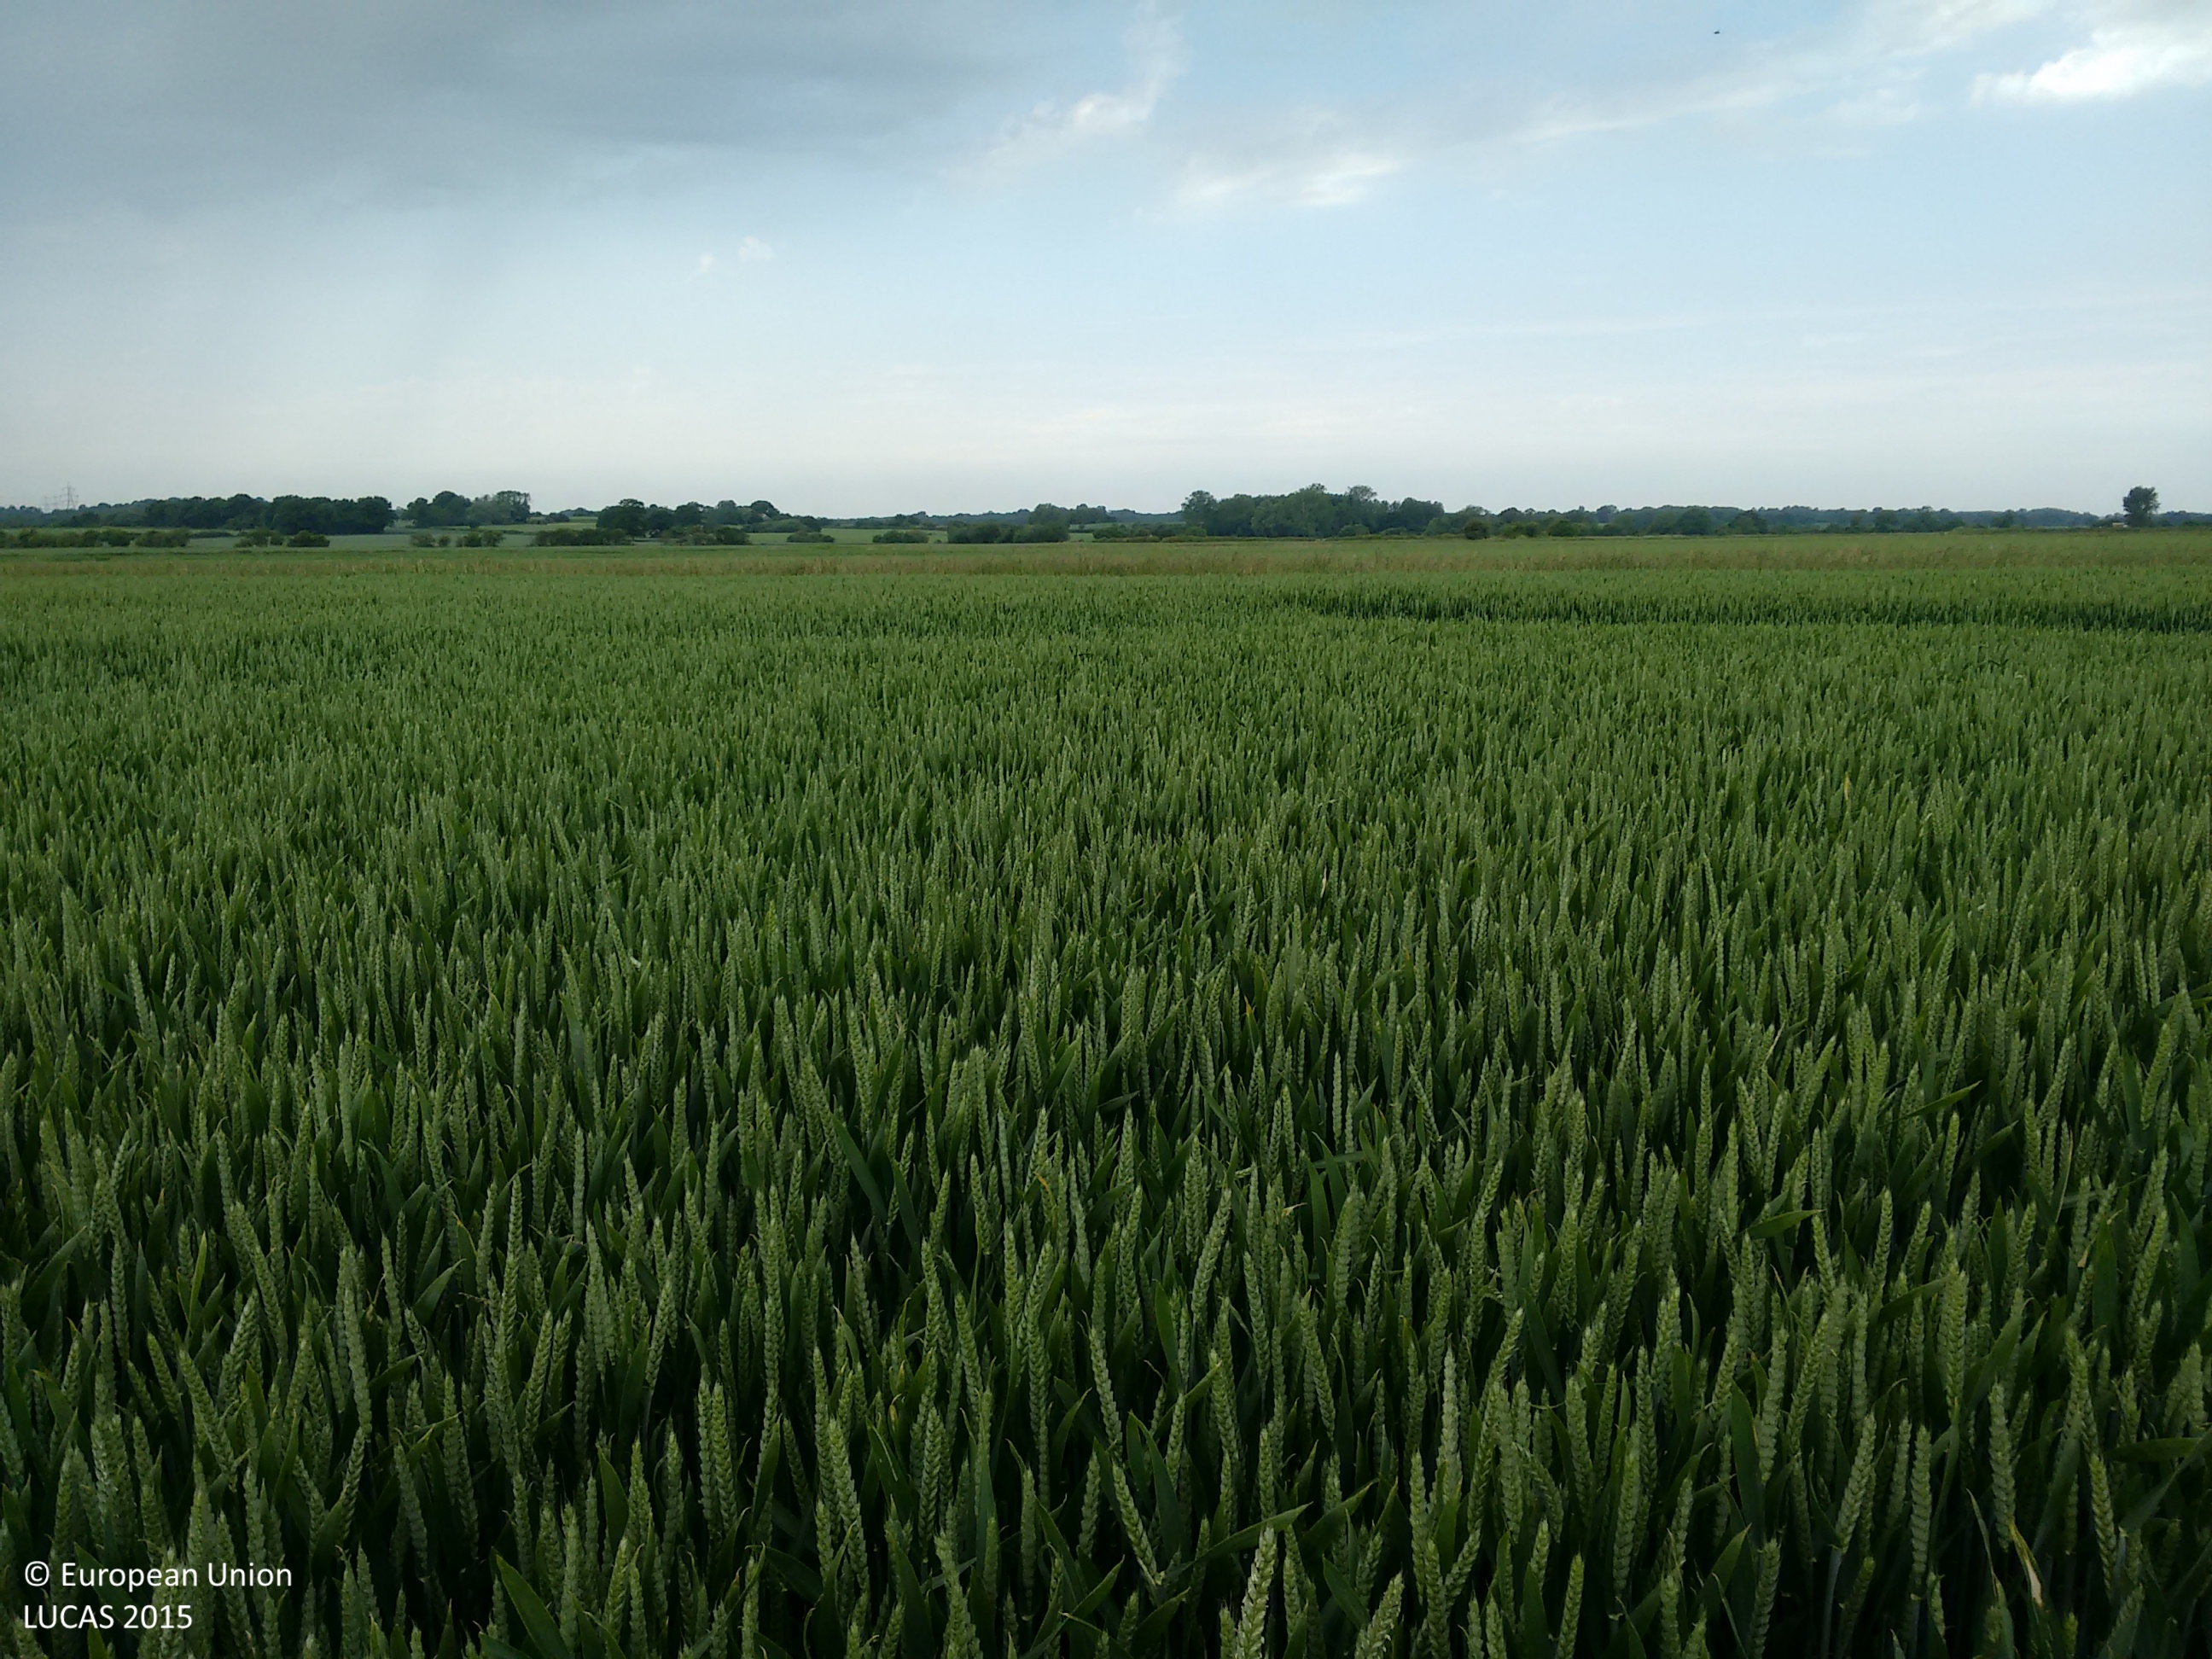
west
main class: Cropland
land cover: Common wheat
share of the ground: > 75 %
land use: Agriculture (excluding fallow land and kitchen gardens)
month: June
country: GB
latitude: 50.9980
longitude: 0.6979
